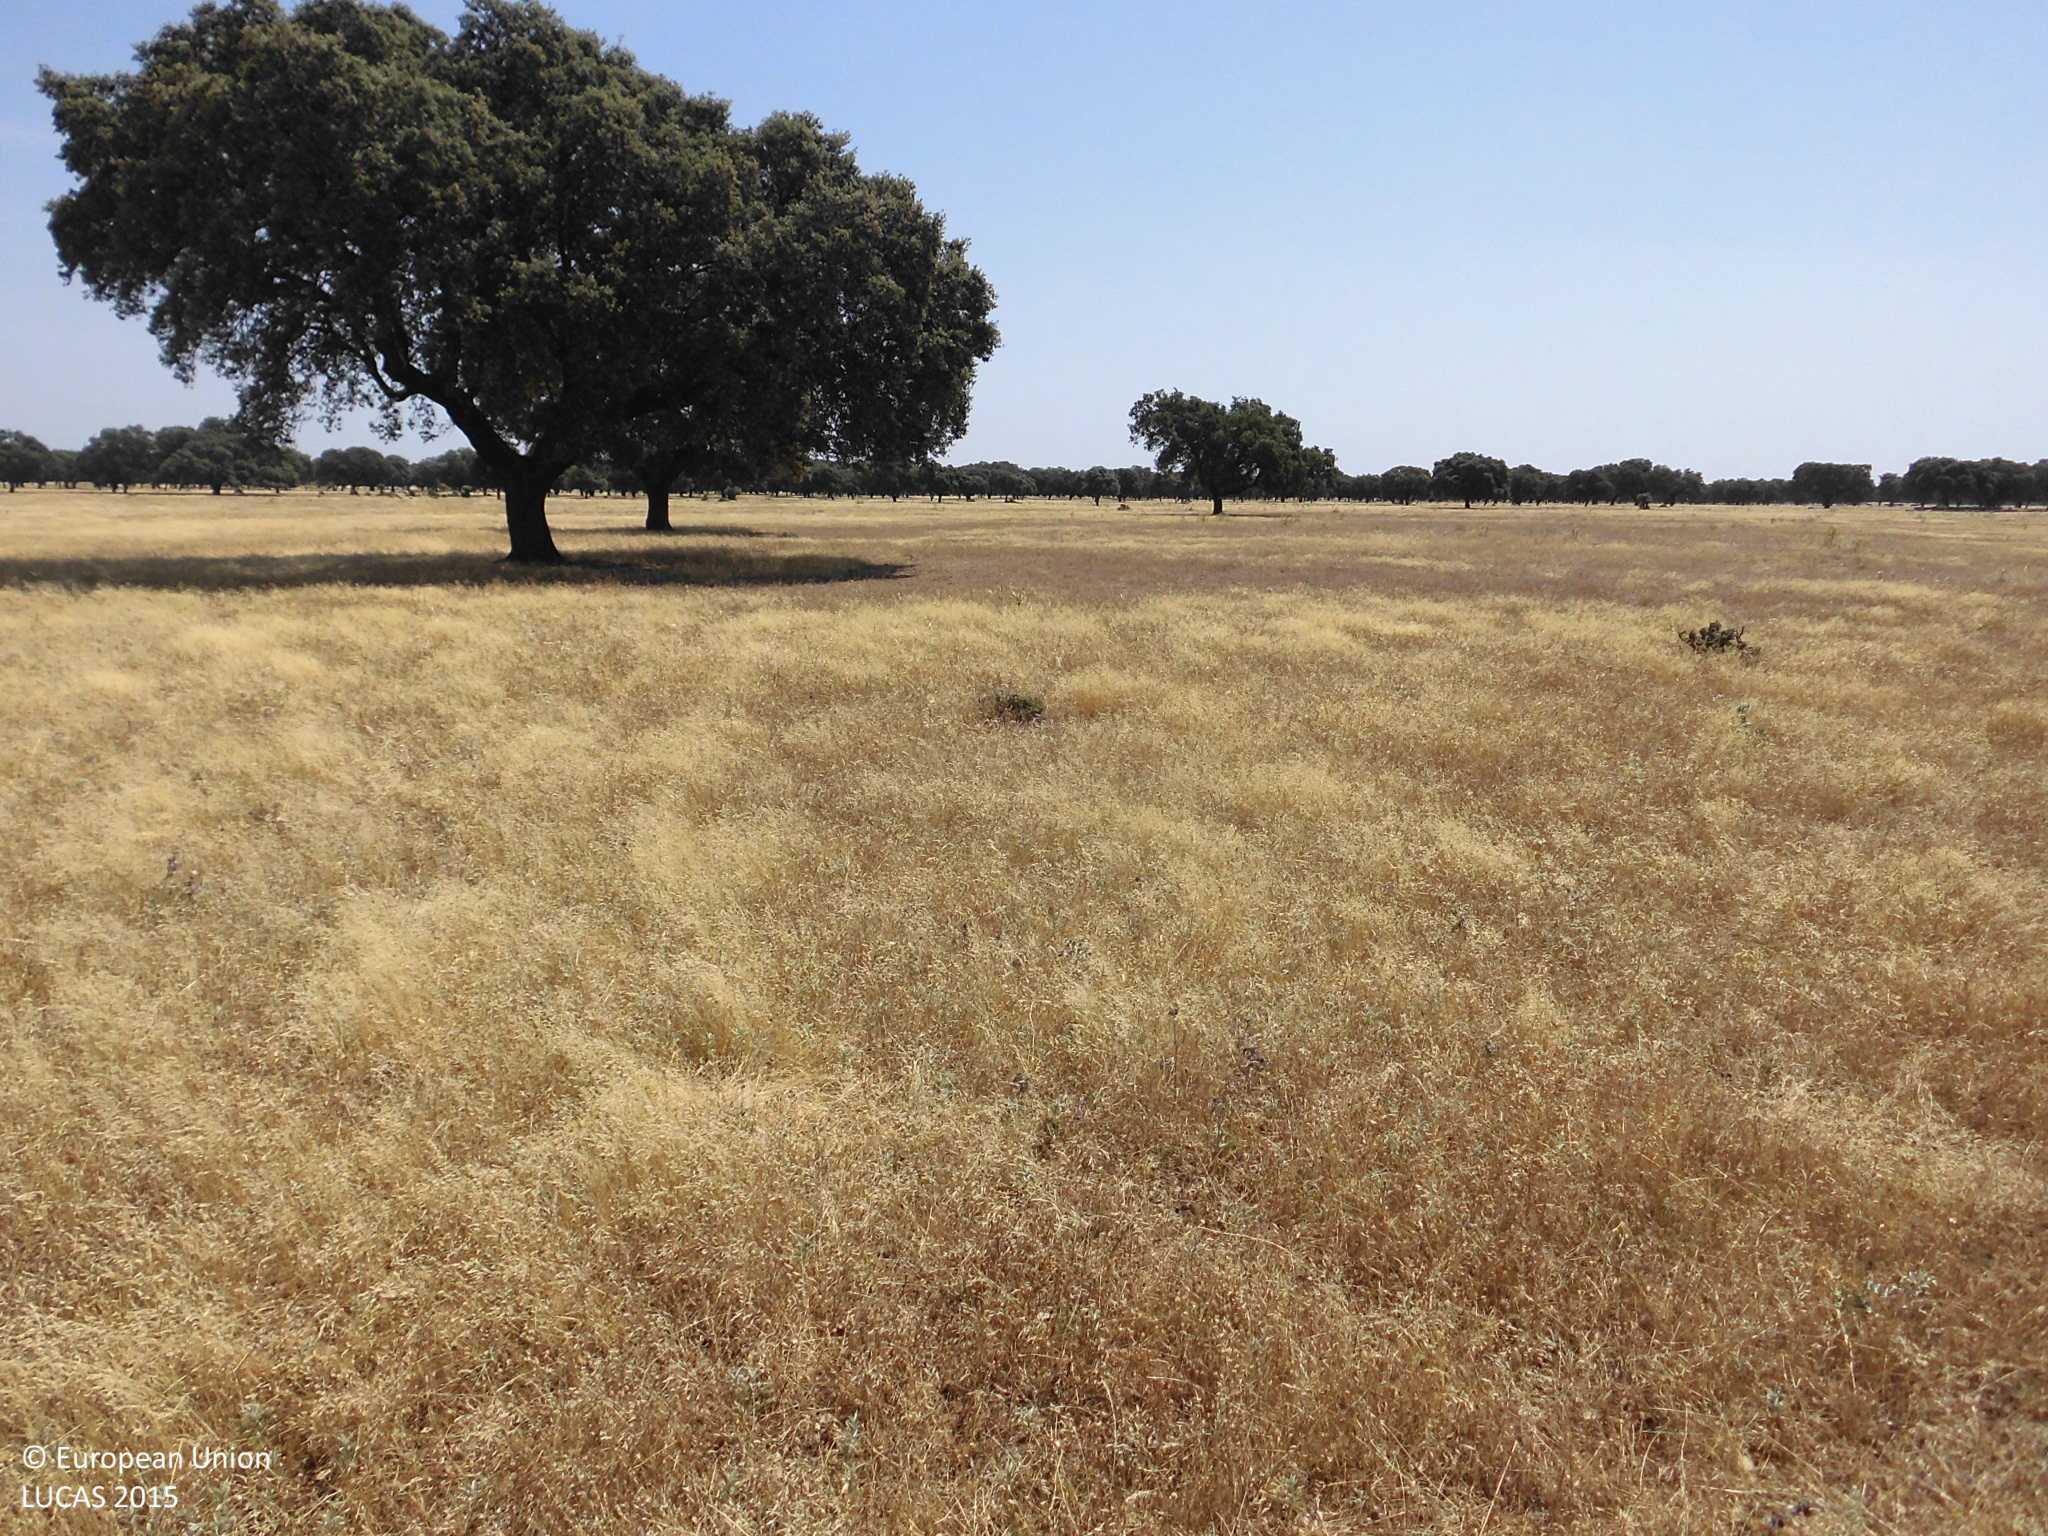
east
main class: Woodland
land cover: Broadleaved woodland
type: broadleaved evergreen forest
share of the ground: 10 - 25 %
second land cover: Grassland without tree/shrub cover
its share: > 75 %
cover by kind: herbaceous plants 90 %, broadleaved forest trees 10 %
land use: Forestry
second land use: Agriculture (excluding fallow land and kitchen gardens)
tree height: > 5 m
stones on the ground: < 10 %
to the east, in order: Broadleaved woodland; Grassland without tree/shrub cover; Grassland with sparse tree/shrub cover
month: June
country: ES
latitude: 39.9437
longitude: -5.4007
